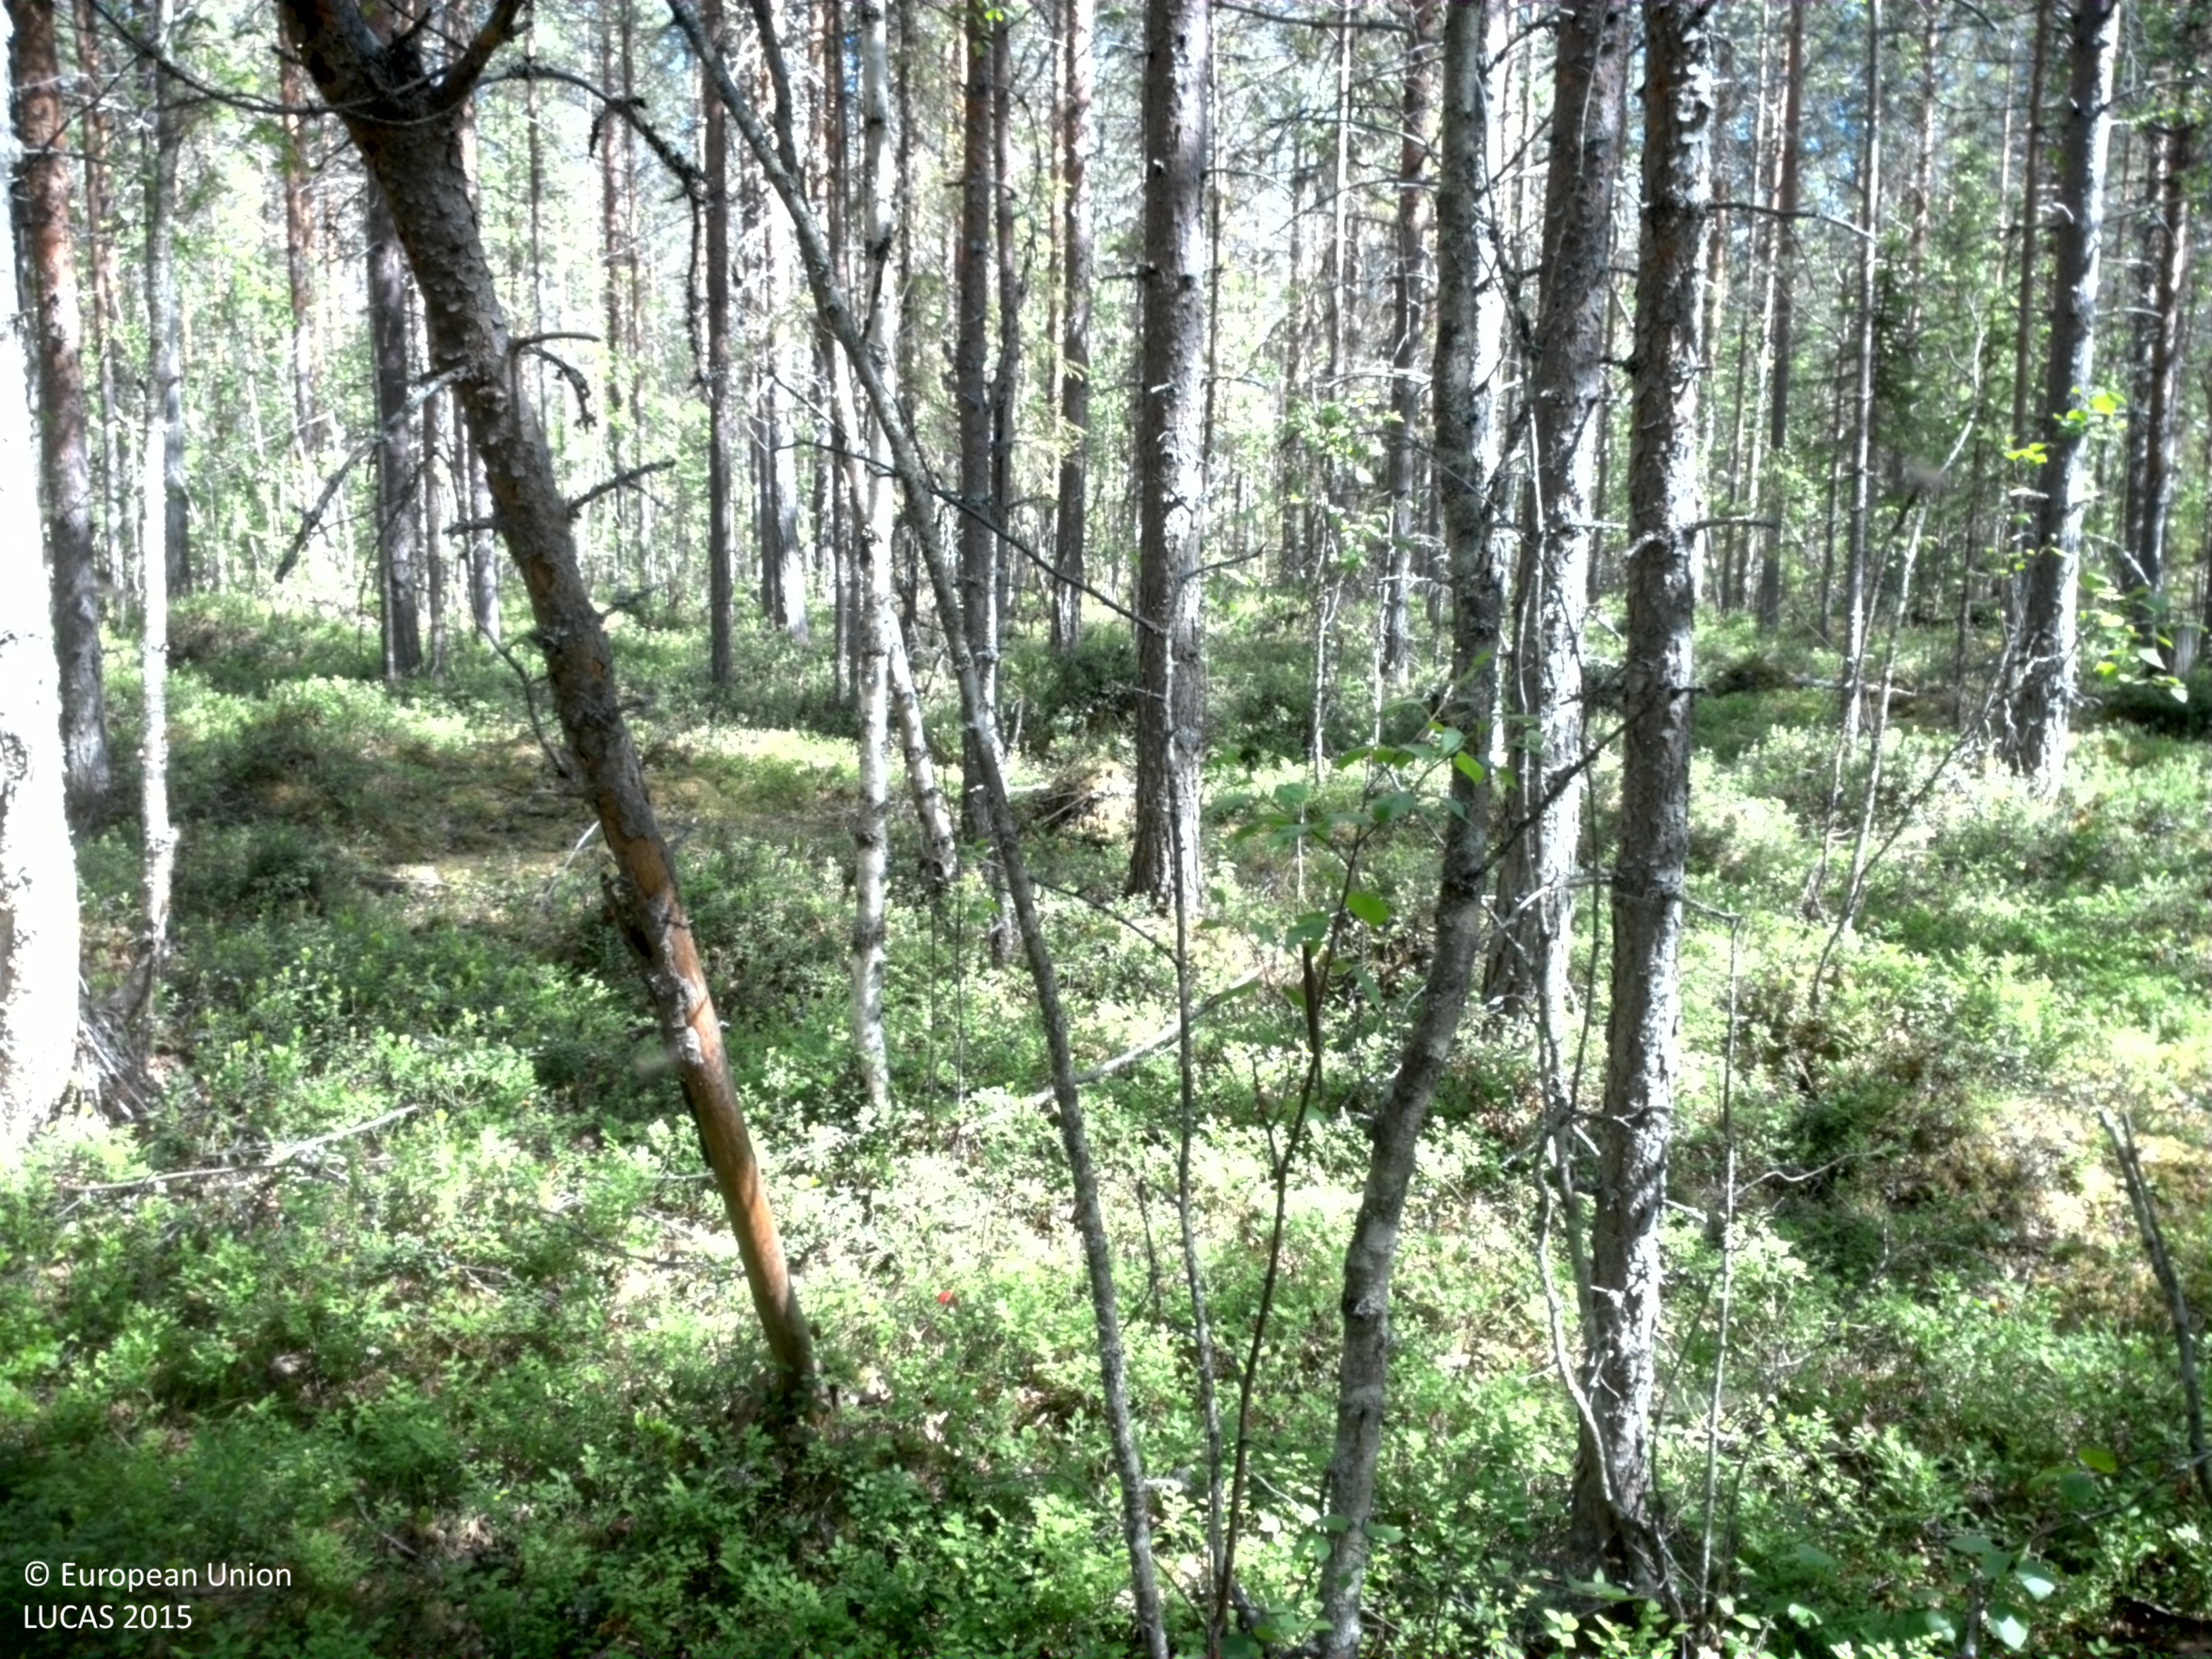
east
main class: Woodland
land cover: Pine dominated mixed woodland
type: boreal forest
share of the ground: 50 - 75 %
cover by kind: shrubs 45 %, coniferous forest trees 35 %, broadleaved forest trees 20 %
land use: Forestry
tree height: > 5 m
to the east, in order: Pine dominated mixed woodland; Shrubland with sparse tree cover; Pine dominated coniferous woodland; Shrubland with sparse tree cover; Pine dominated coniferous woodland
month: June
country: SE
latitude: 66.4779
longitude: 22.6603
